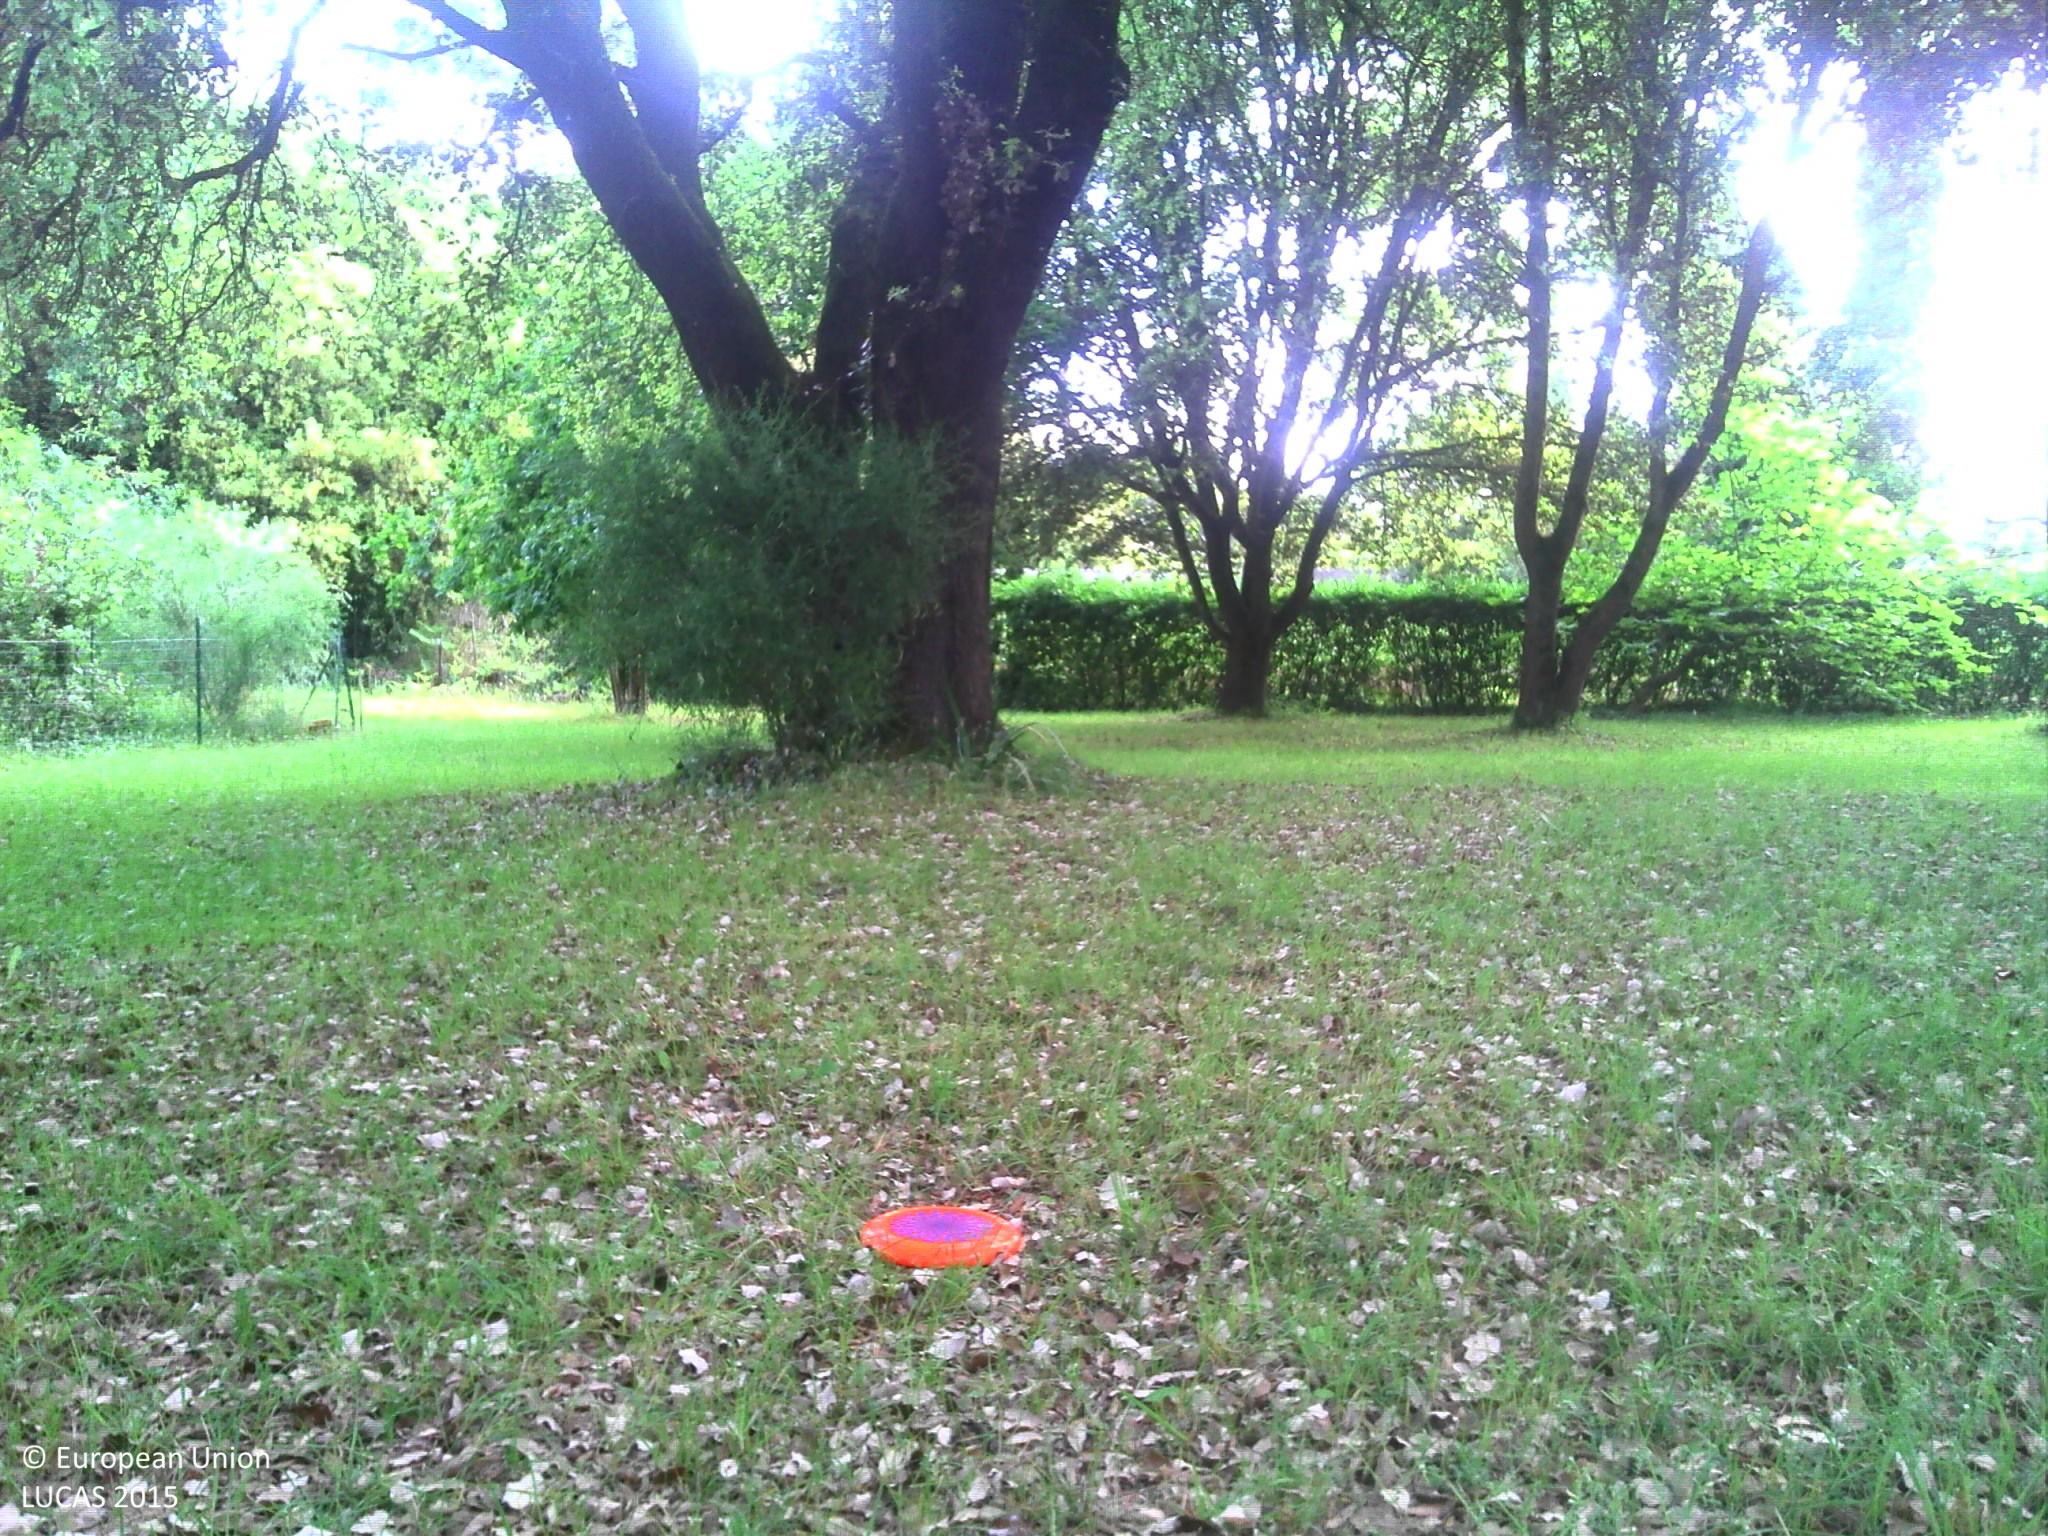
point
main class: Woodland
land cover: Broadleaved woodland
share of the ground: > 75 %
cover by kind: broadleaved forest trees 90 %, coniferous forest trees 10 %
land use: Residential
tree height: > 5 m
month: May
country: FR
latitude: 45.8825
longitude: -1.2546
